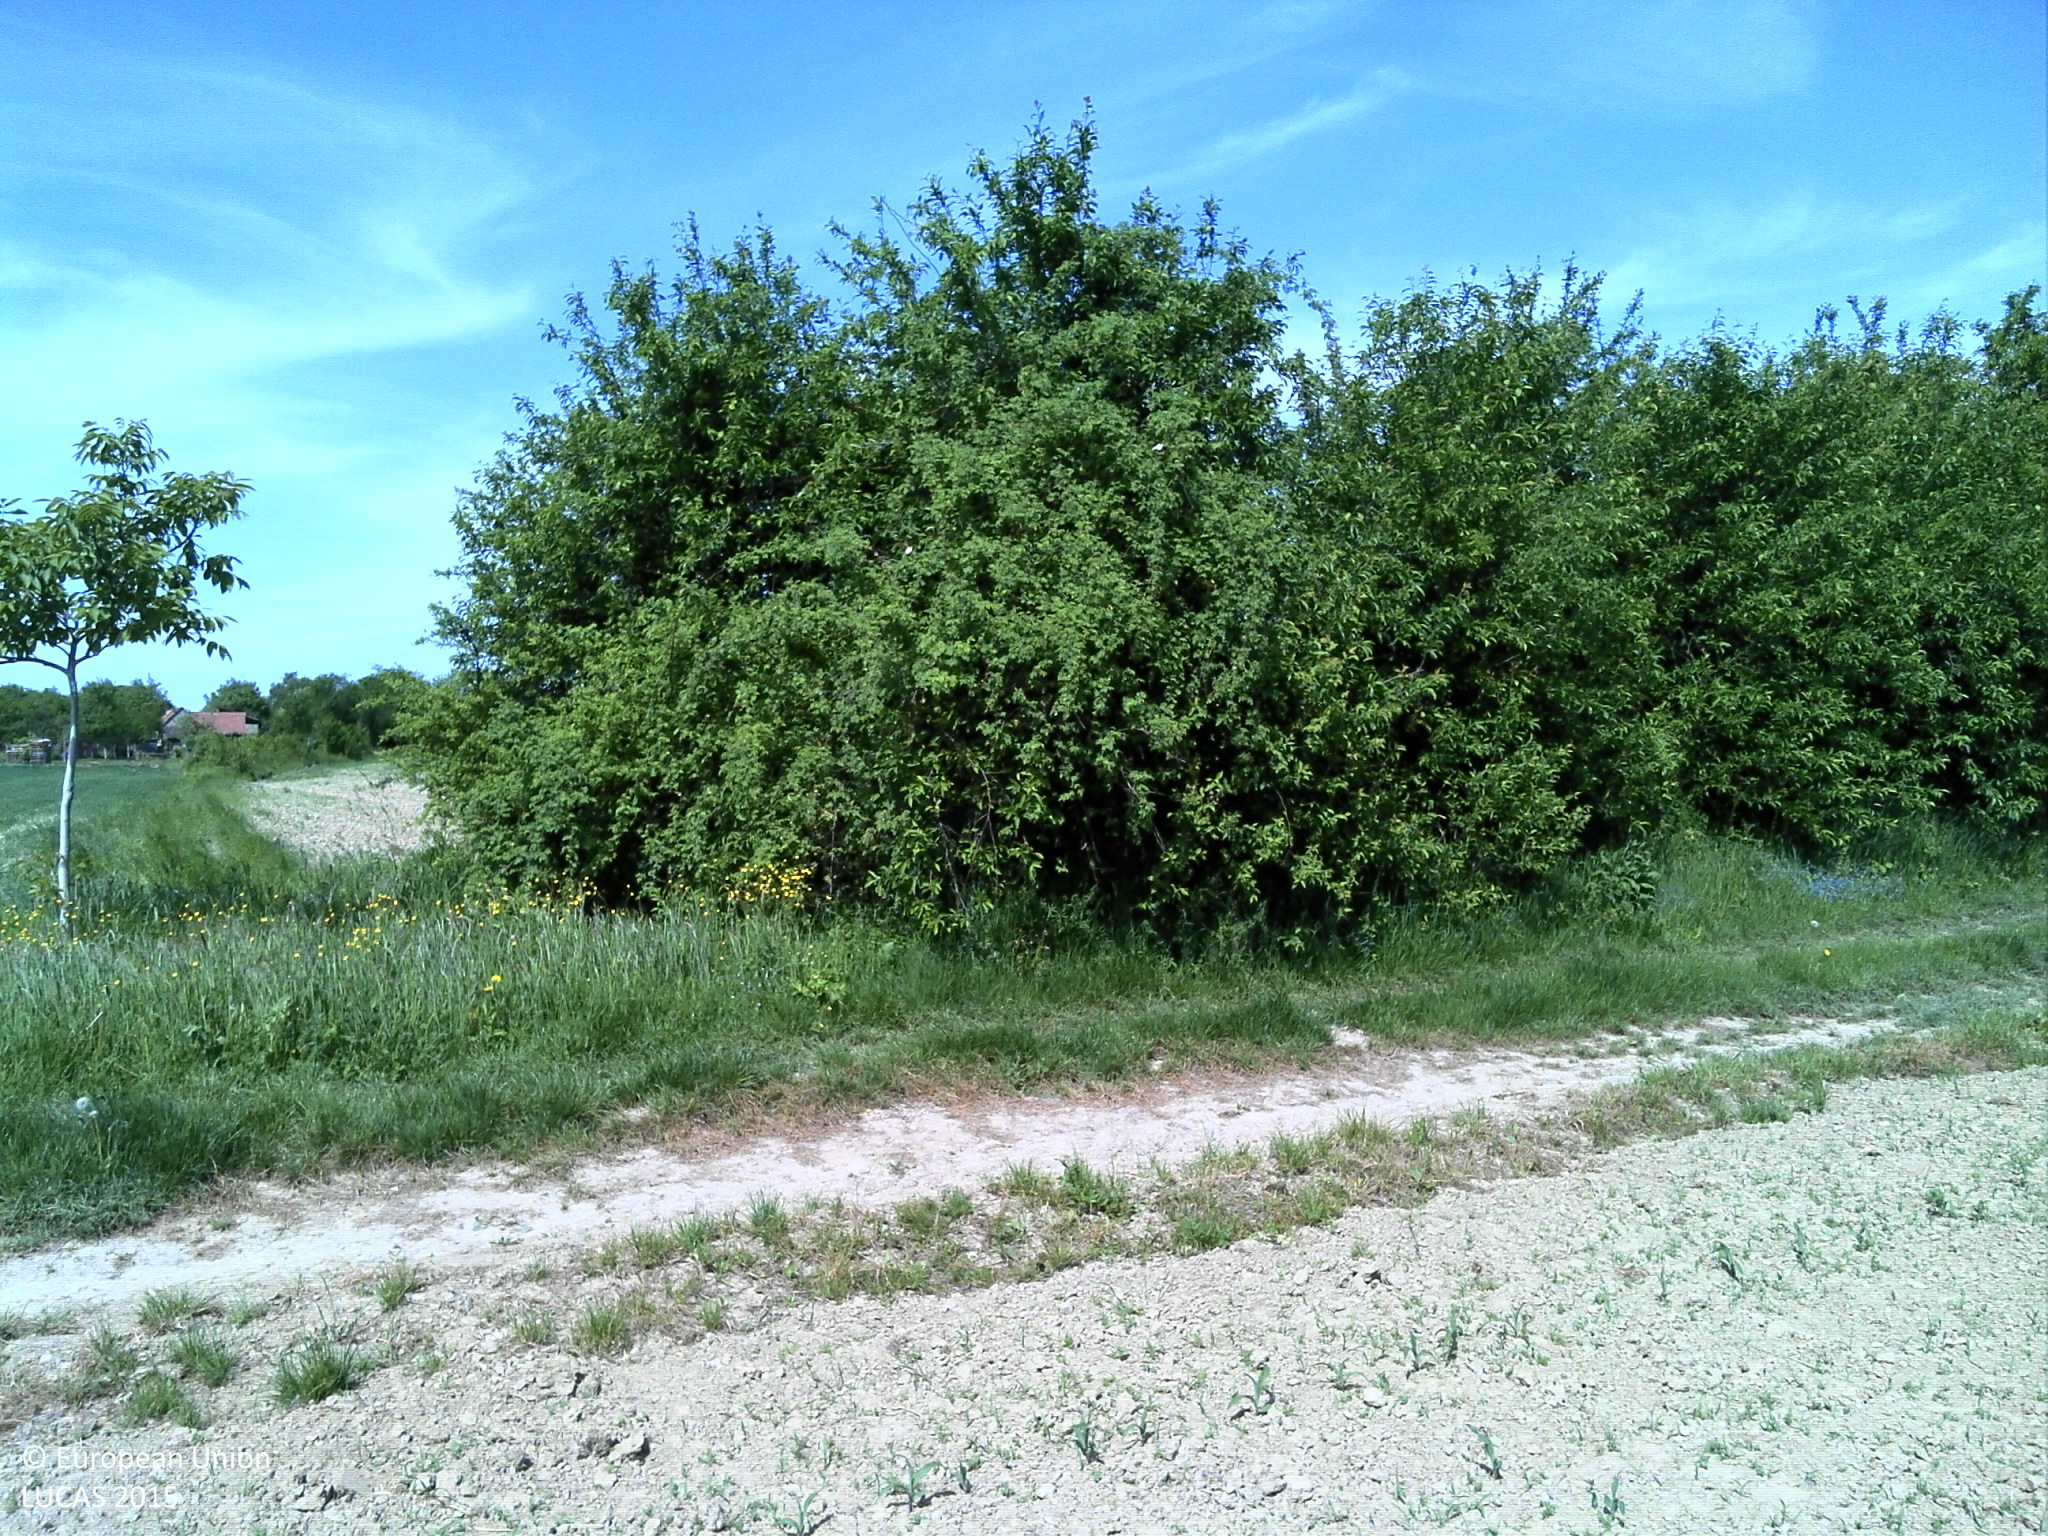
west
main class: Cropland
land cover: Maize
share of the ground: < 10 %
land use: Agriculture (excluding fallow land and kitchen gardens)
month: May
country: HR
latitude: 45.4546
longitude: 18.2270
